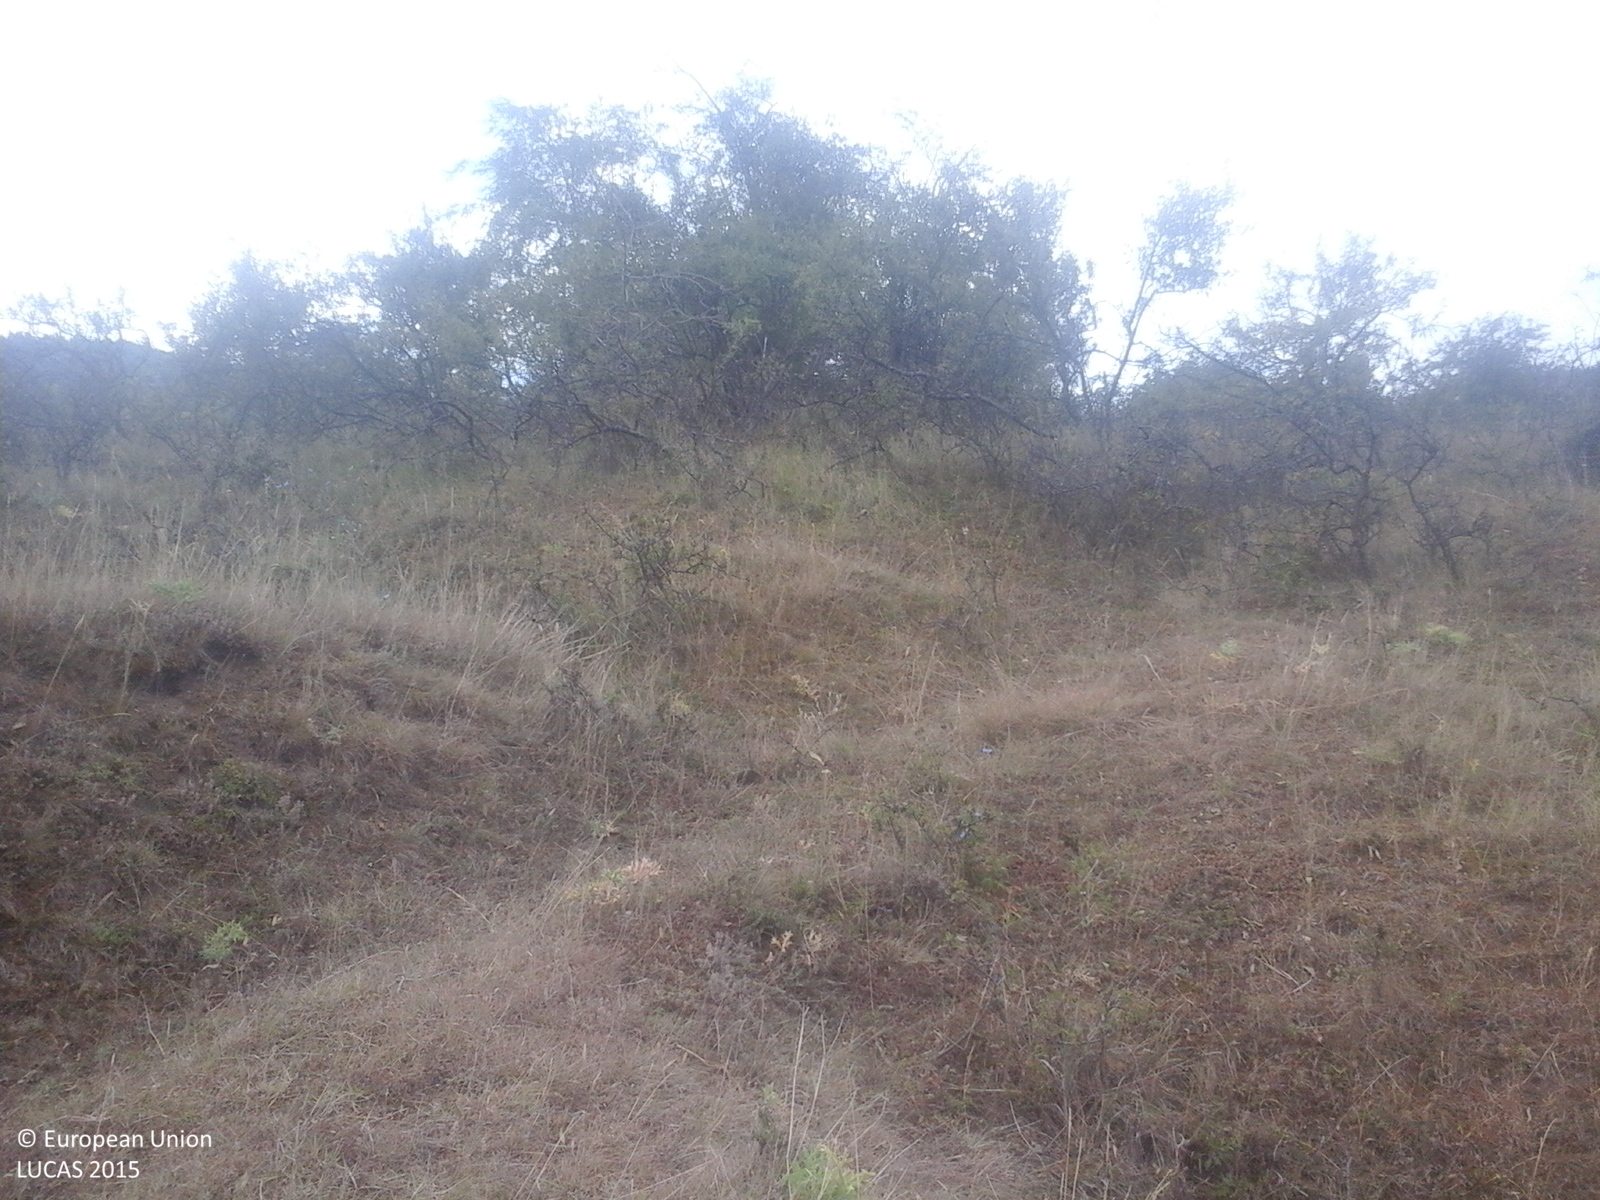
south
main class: Grassland
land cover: Grassland with sparse tree/shrub cover
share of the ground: > 75 %
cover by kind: herbaceous plants 85 %, shrubs 10 %, broadleaved forest trees 5 %
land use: Agriculture (excluding fallow land and kitchen gardens)
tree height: < 5 m
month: July
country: RO
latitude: 46.5791
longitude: 27.8832
